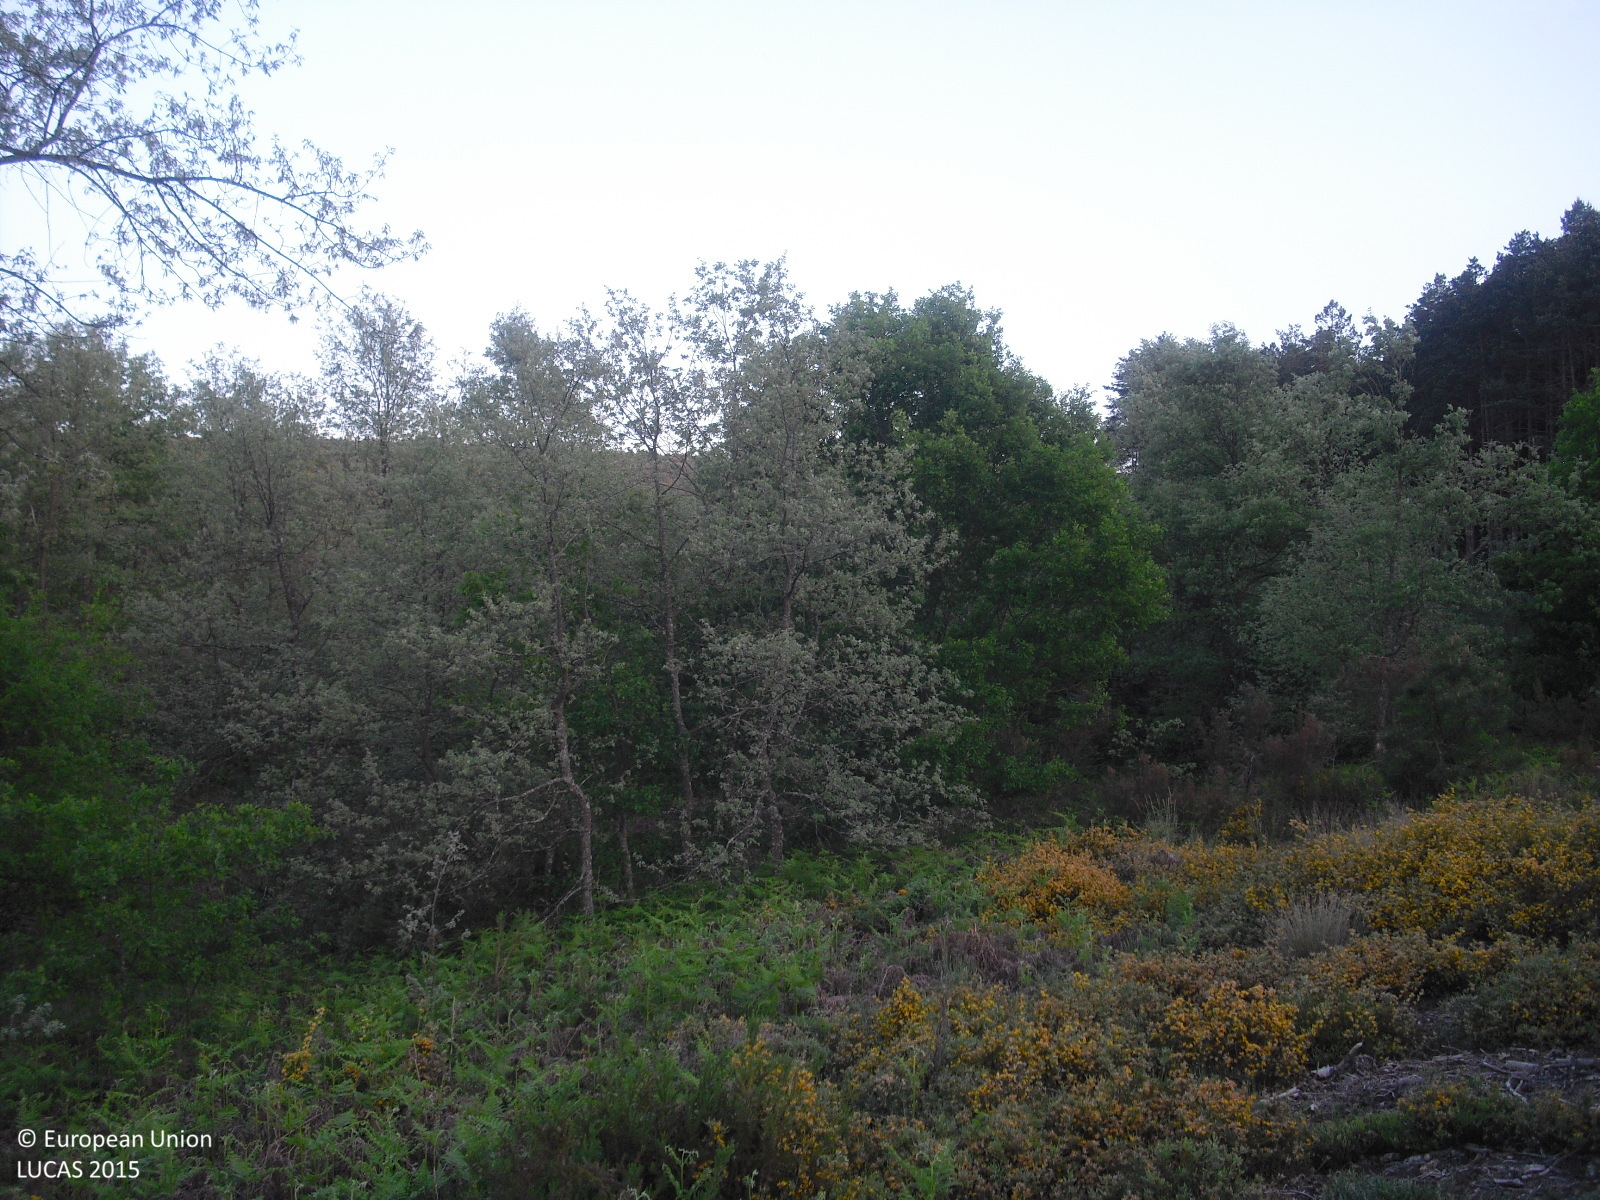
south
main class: Shrubland
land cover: Shrubland with sparse tree cover
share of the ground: > 75 %
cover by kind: shrubs 70 %, unconsolidated bare surface 25 %, broadleaved forest trees 5 %
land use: Forestry
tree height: < 5 m
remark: Clear cut
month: May
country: ES
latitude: 42.0659
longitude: -7.5521
